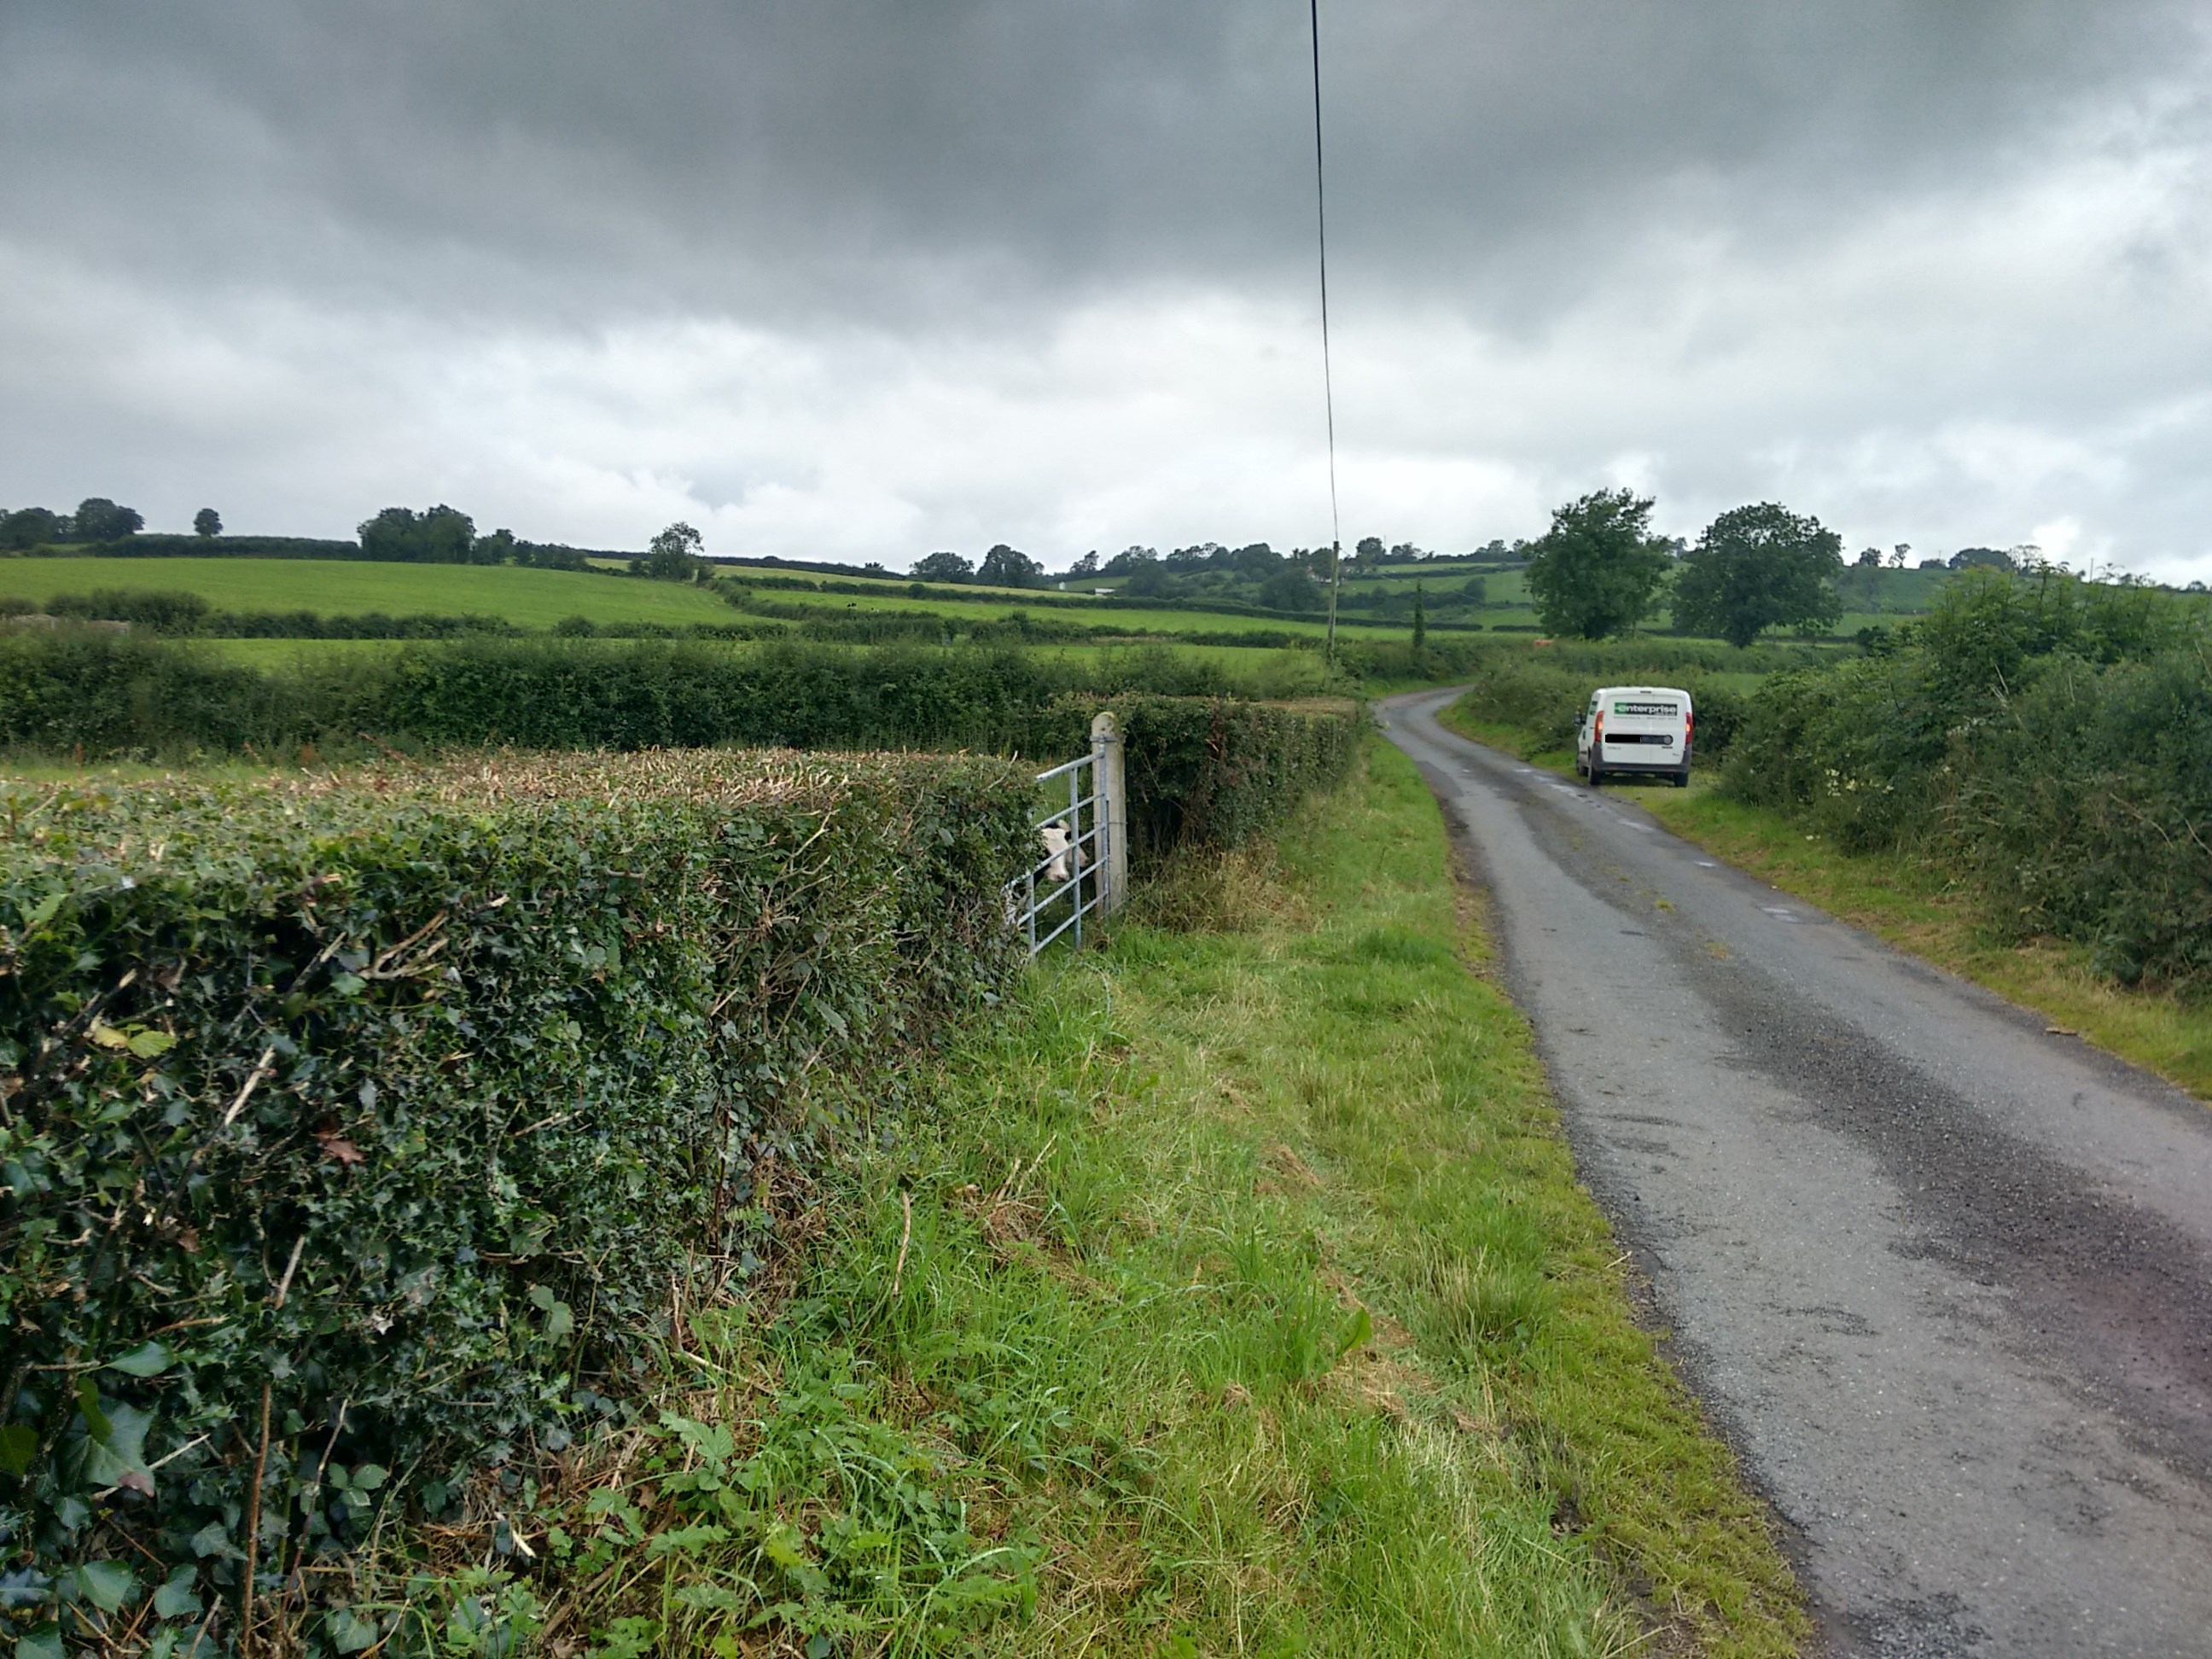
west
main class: Grassland
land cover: Grassland without tree/shrub cover
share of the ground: > 75 %
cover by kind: herbaceous plants 100 %
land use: Agriculture (excluding fallow land and kitchen gardens)
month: August
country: GB
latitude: 54.4026
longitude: -6.8175
